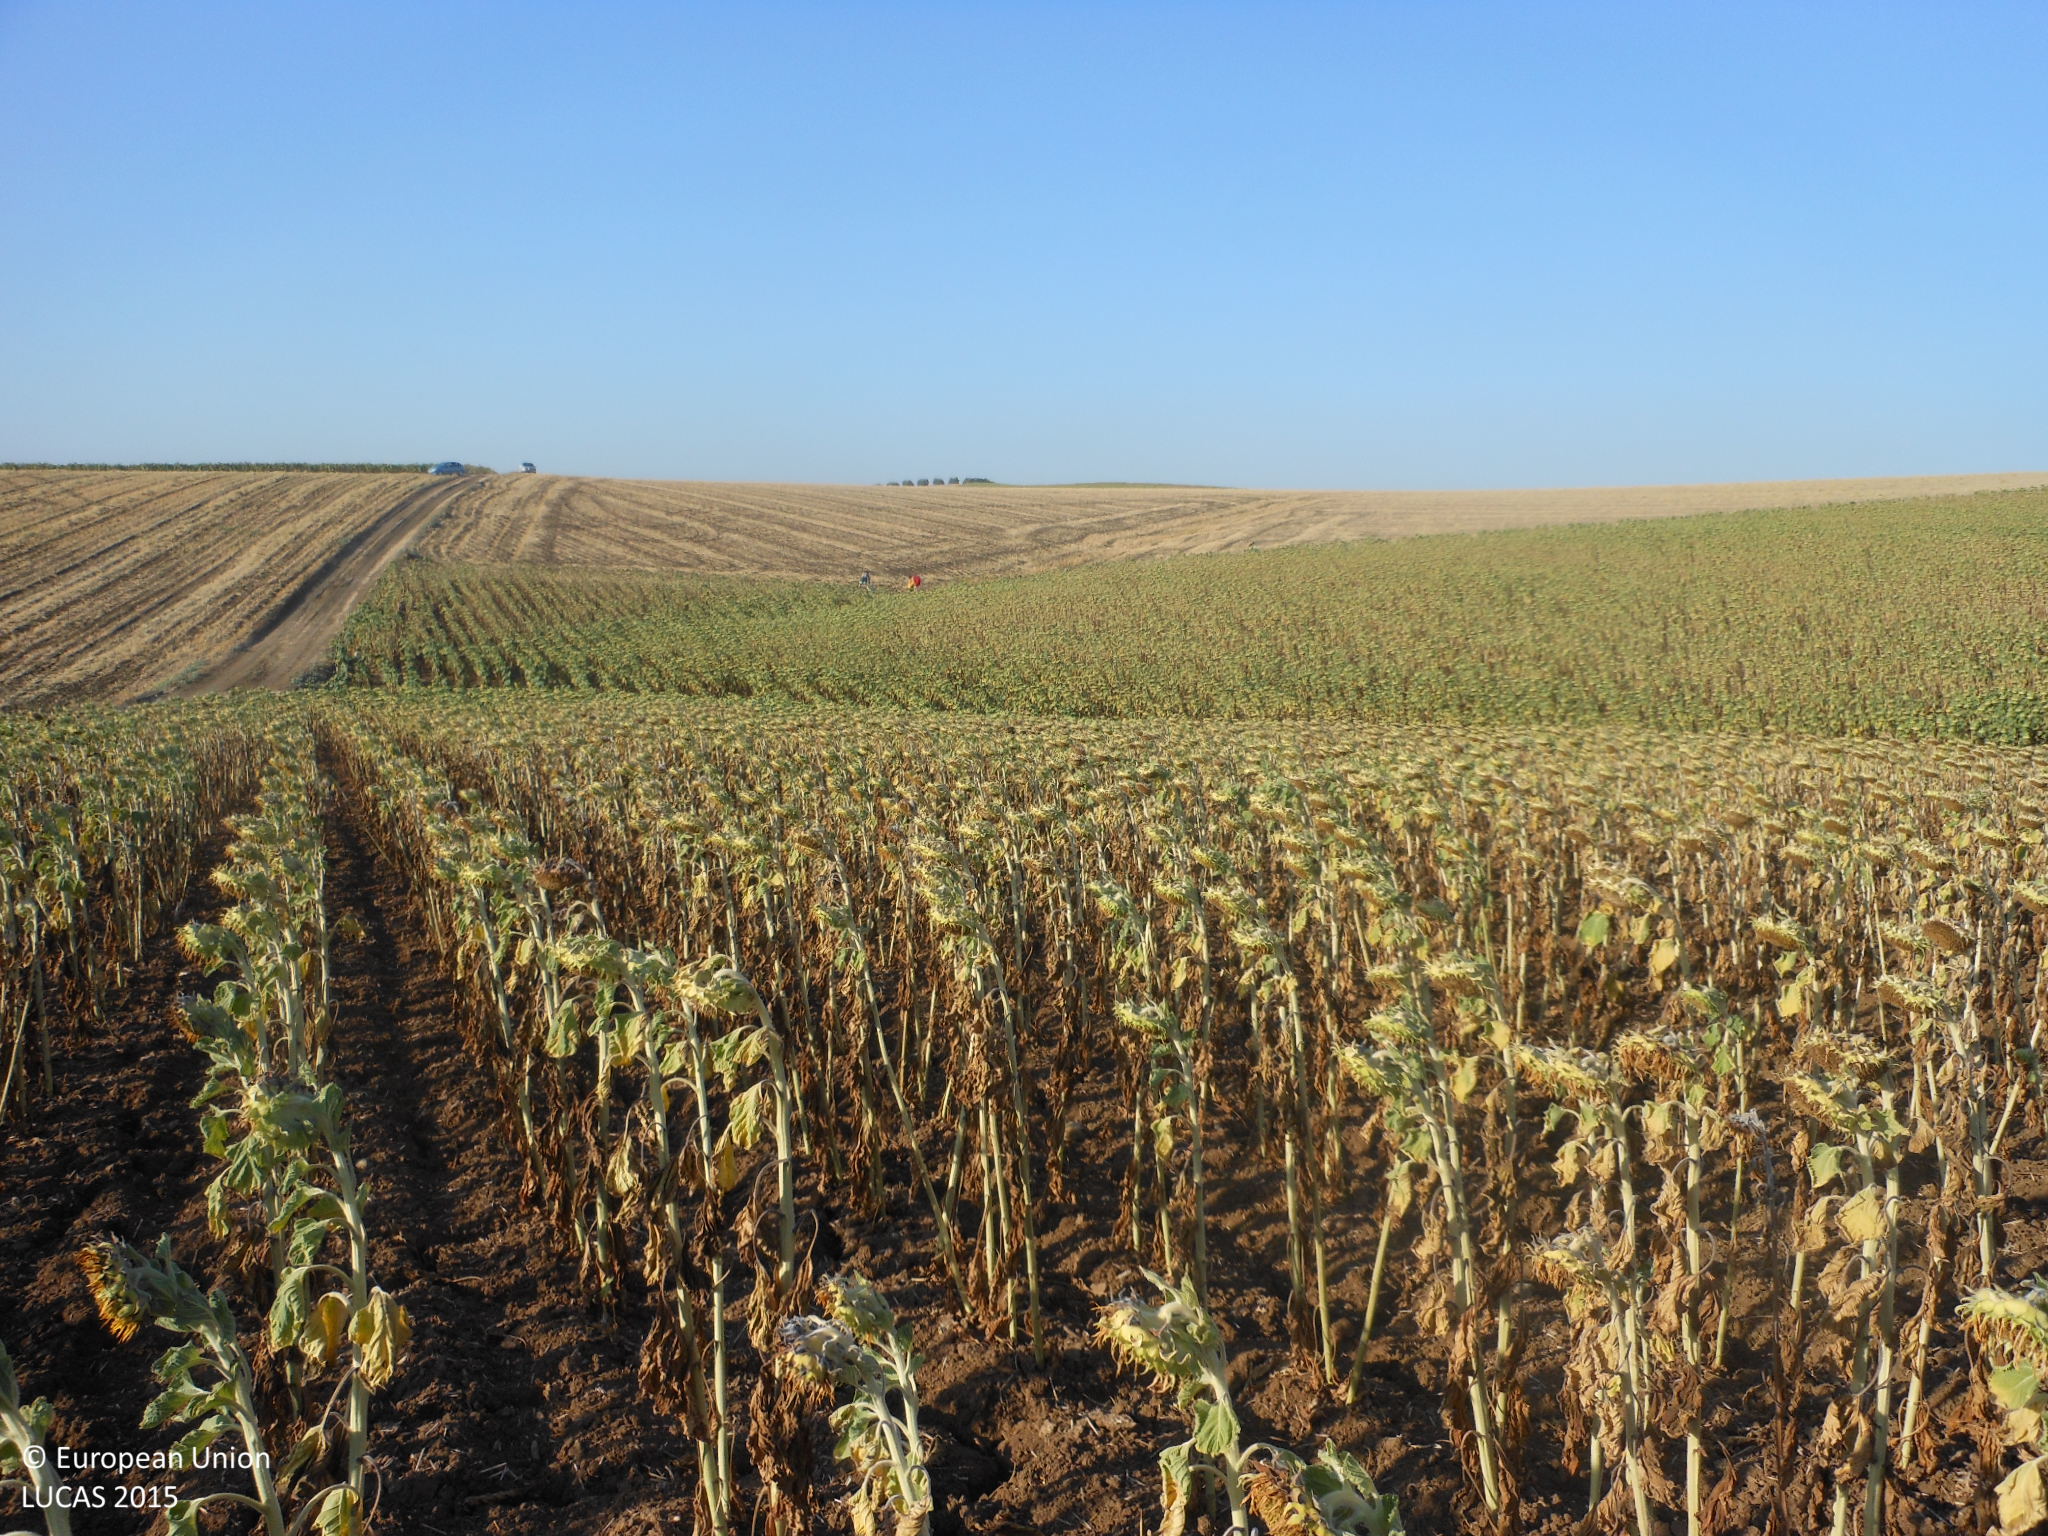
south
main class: Cropland
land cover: Sunflower
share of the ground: 50 - 75 %
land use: Agriculture (excluding fallow land and kitchen gardens)
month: June
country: ES
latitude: 37.5571
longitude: -4.9193
